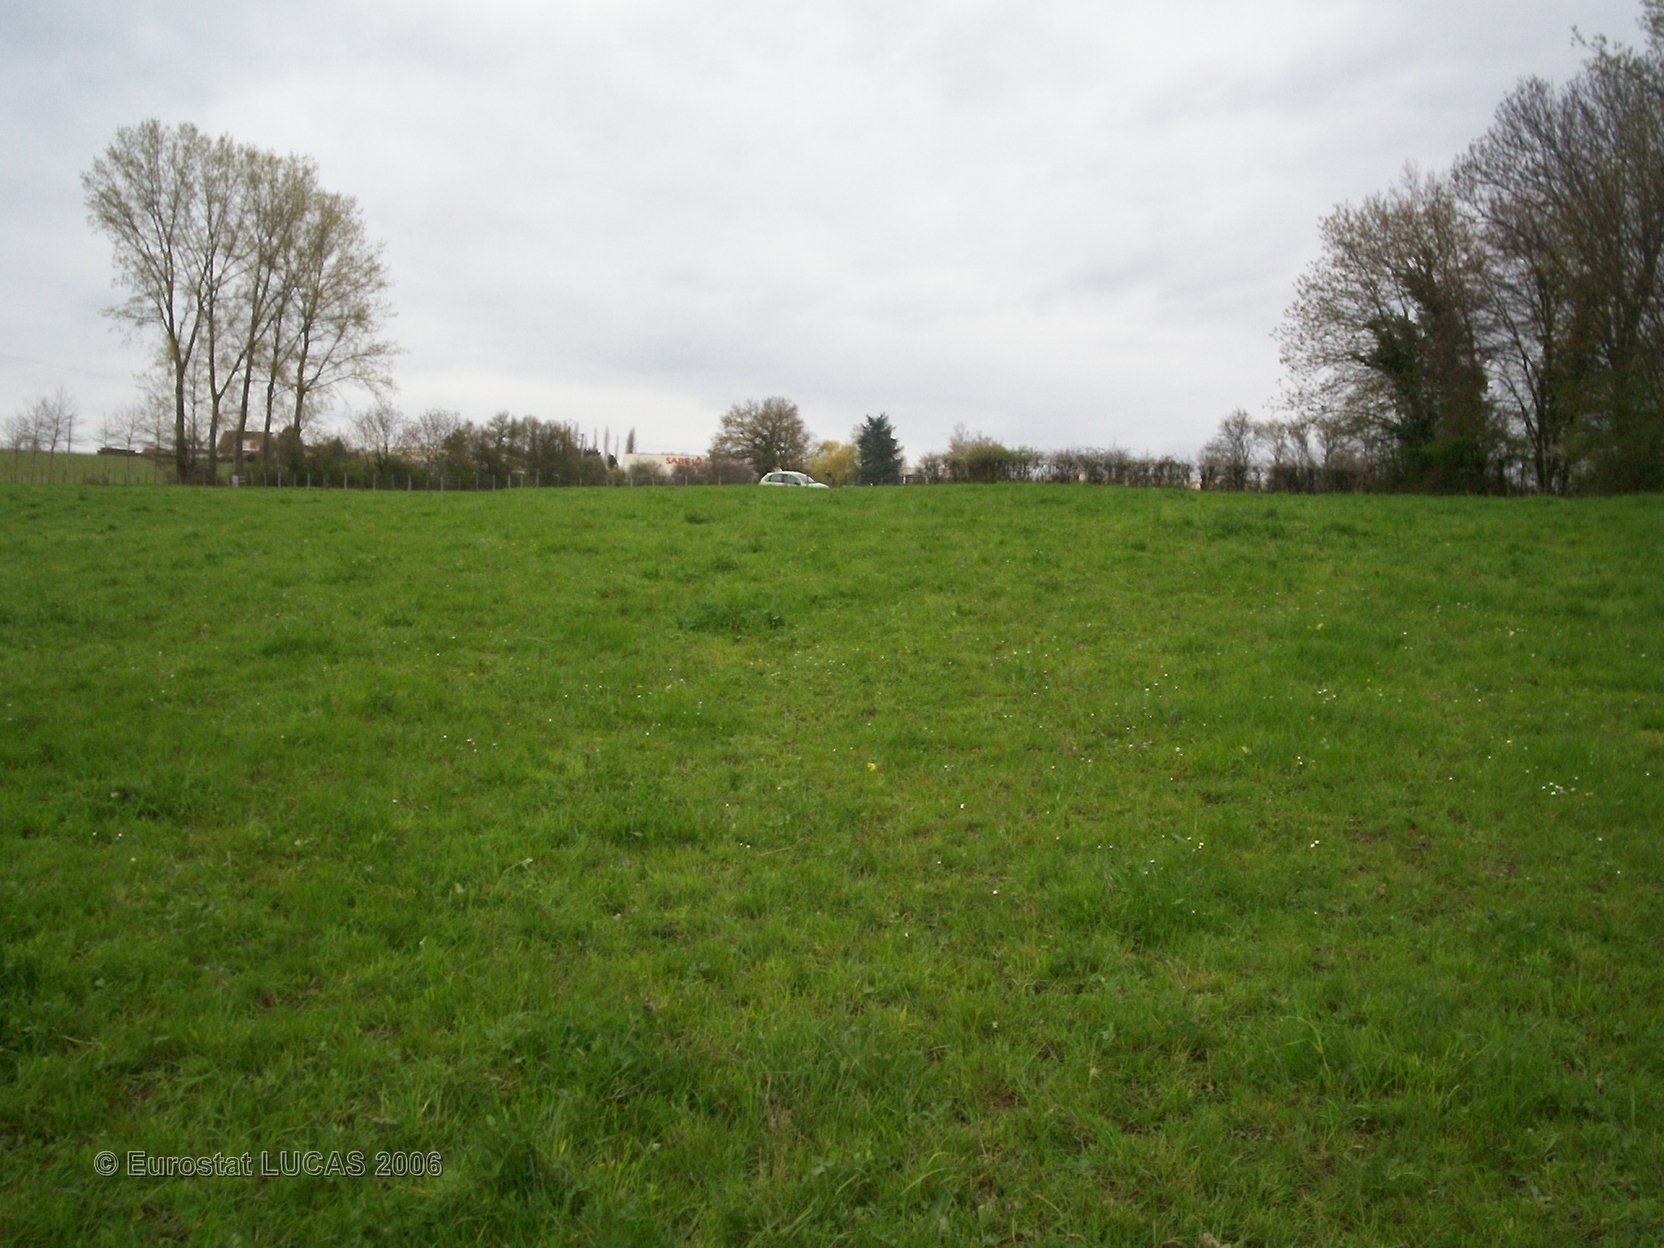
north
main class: Grassland
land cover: Grassland without tree/shrub cover
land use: Agriculture (excluding fallow land and kitchen gardens)
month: April
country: FR
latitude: 46.2416
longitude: 4.7759
